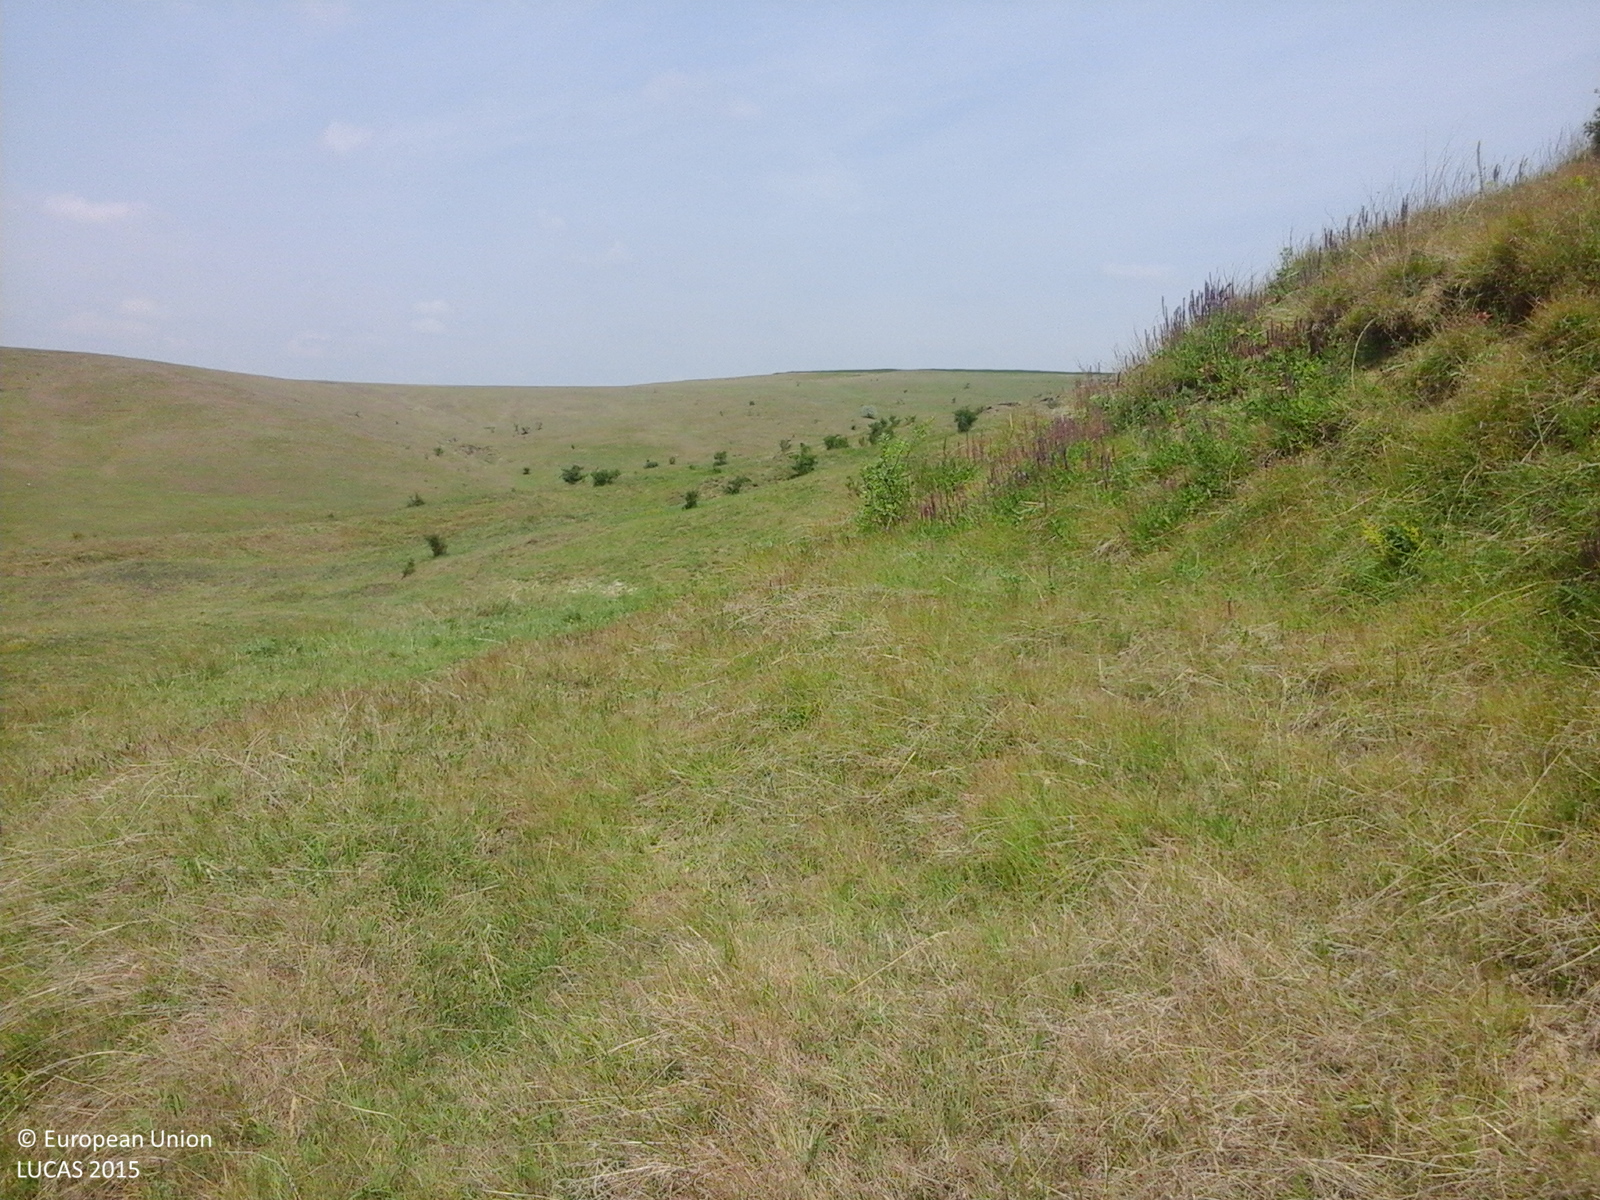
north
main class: Grassland
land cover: Grassland with sparse tree/shrub cover
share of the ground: > 75 %
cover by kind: herbaceous plants 90 %, broadleaved forest trees 5 %, shrubs 5 %
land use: Agriculture (excluding fallow land and kitchen gardens)
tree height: < 5 m
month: June
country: RO
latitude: 47.4094
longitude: 26.9721
